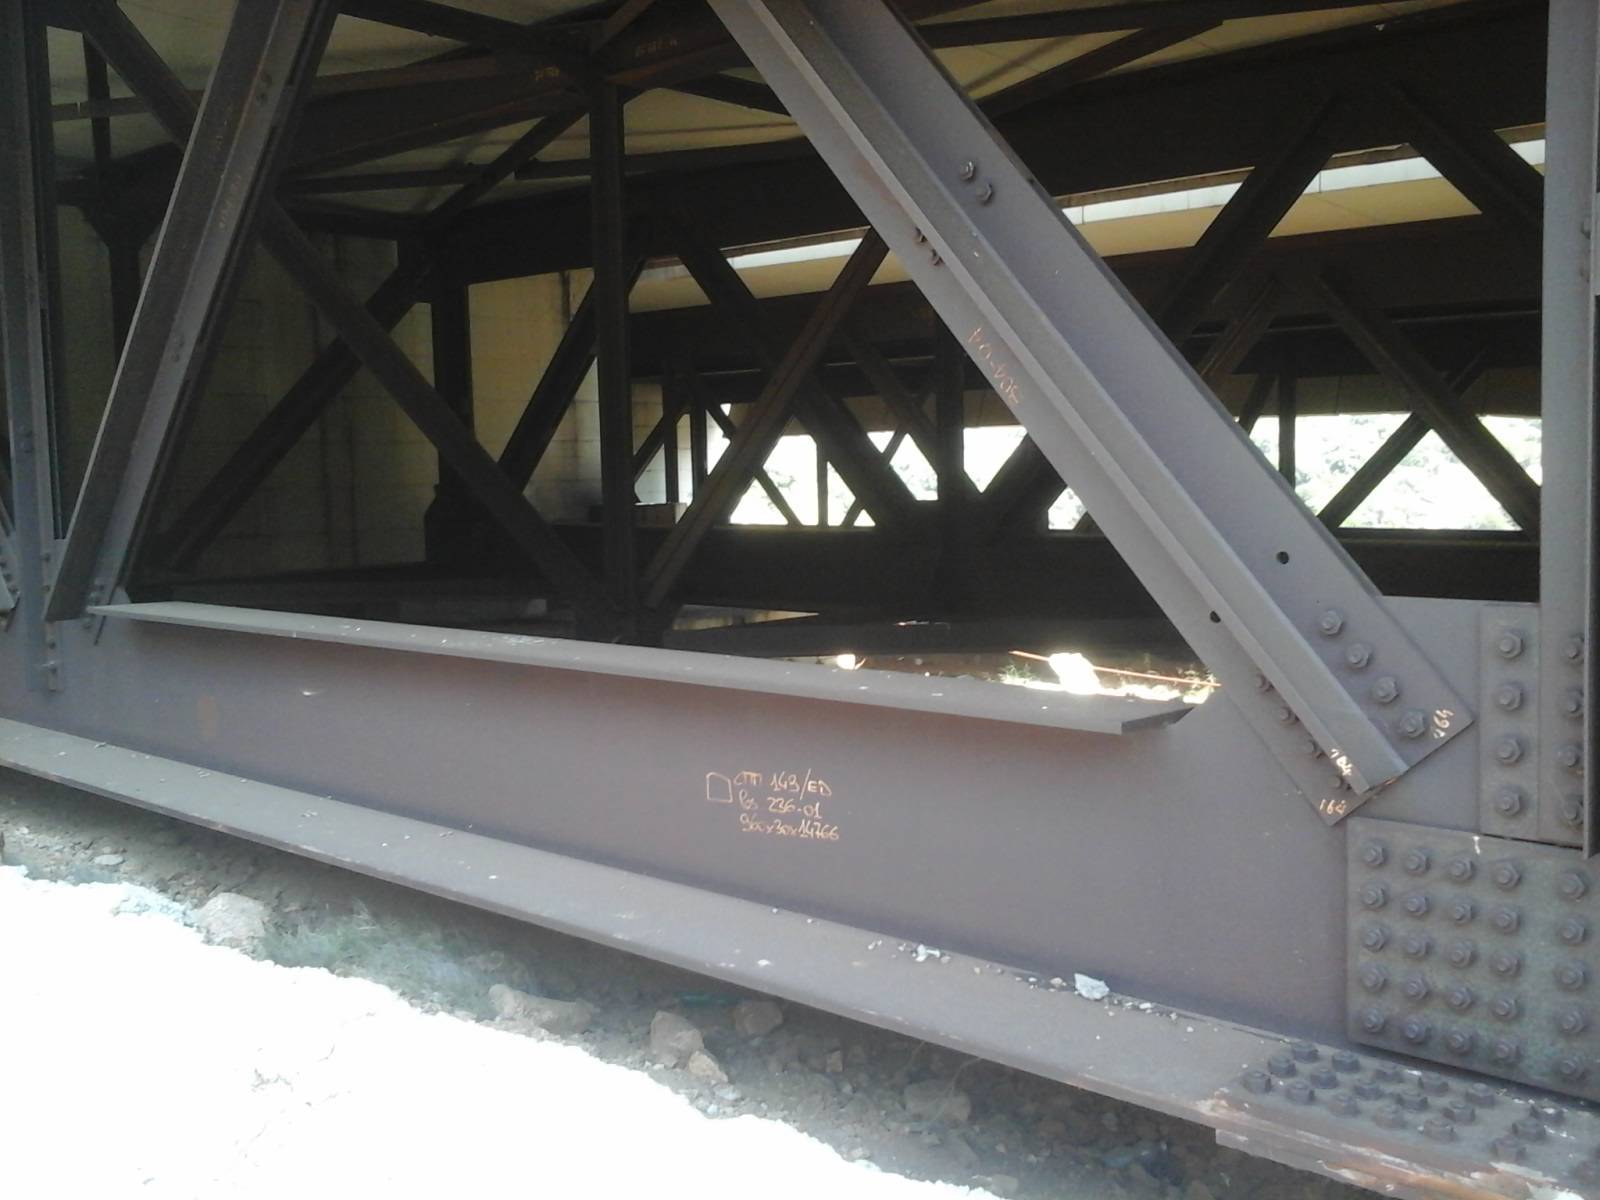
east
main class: Woodland
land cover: Broadleaved woodland
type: broadleaved evergreen forest
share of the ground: > 75 %
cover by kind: broadleaved forest trees 95 %, shrubs 5 %
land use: Semi-natural and natural areas not in use
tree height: > 5 m
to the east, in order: Broadleaved woodland; Paved roads, cycling and walking lanes; Broadleaved woodland
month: July
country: IT
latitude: 40.7914
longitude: 9.6108
